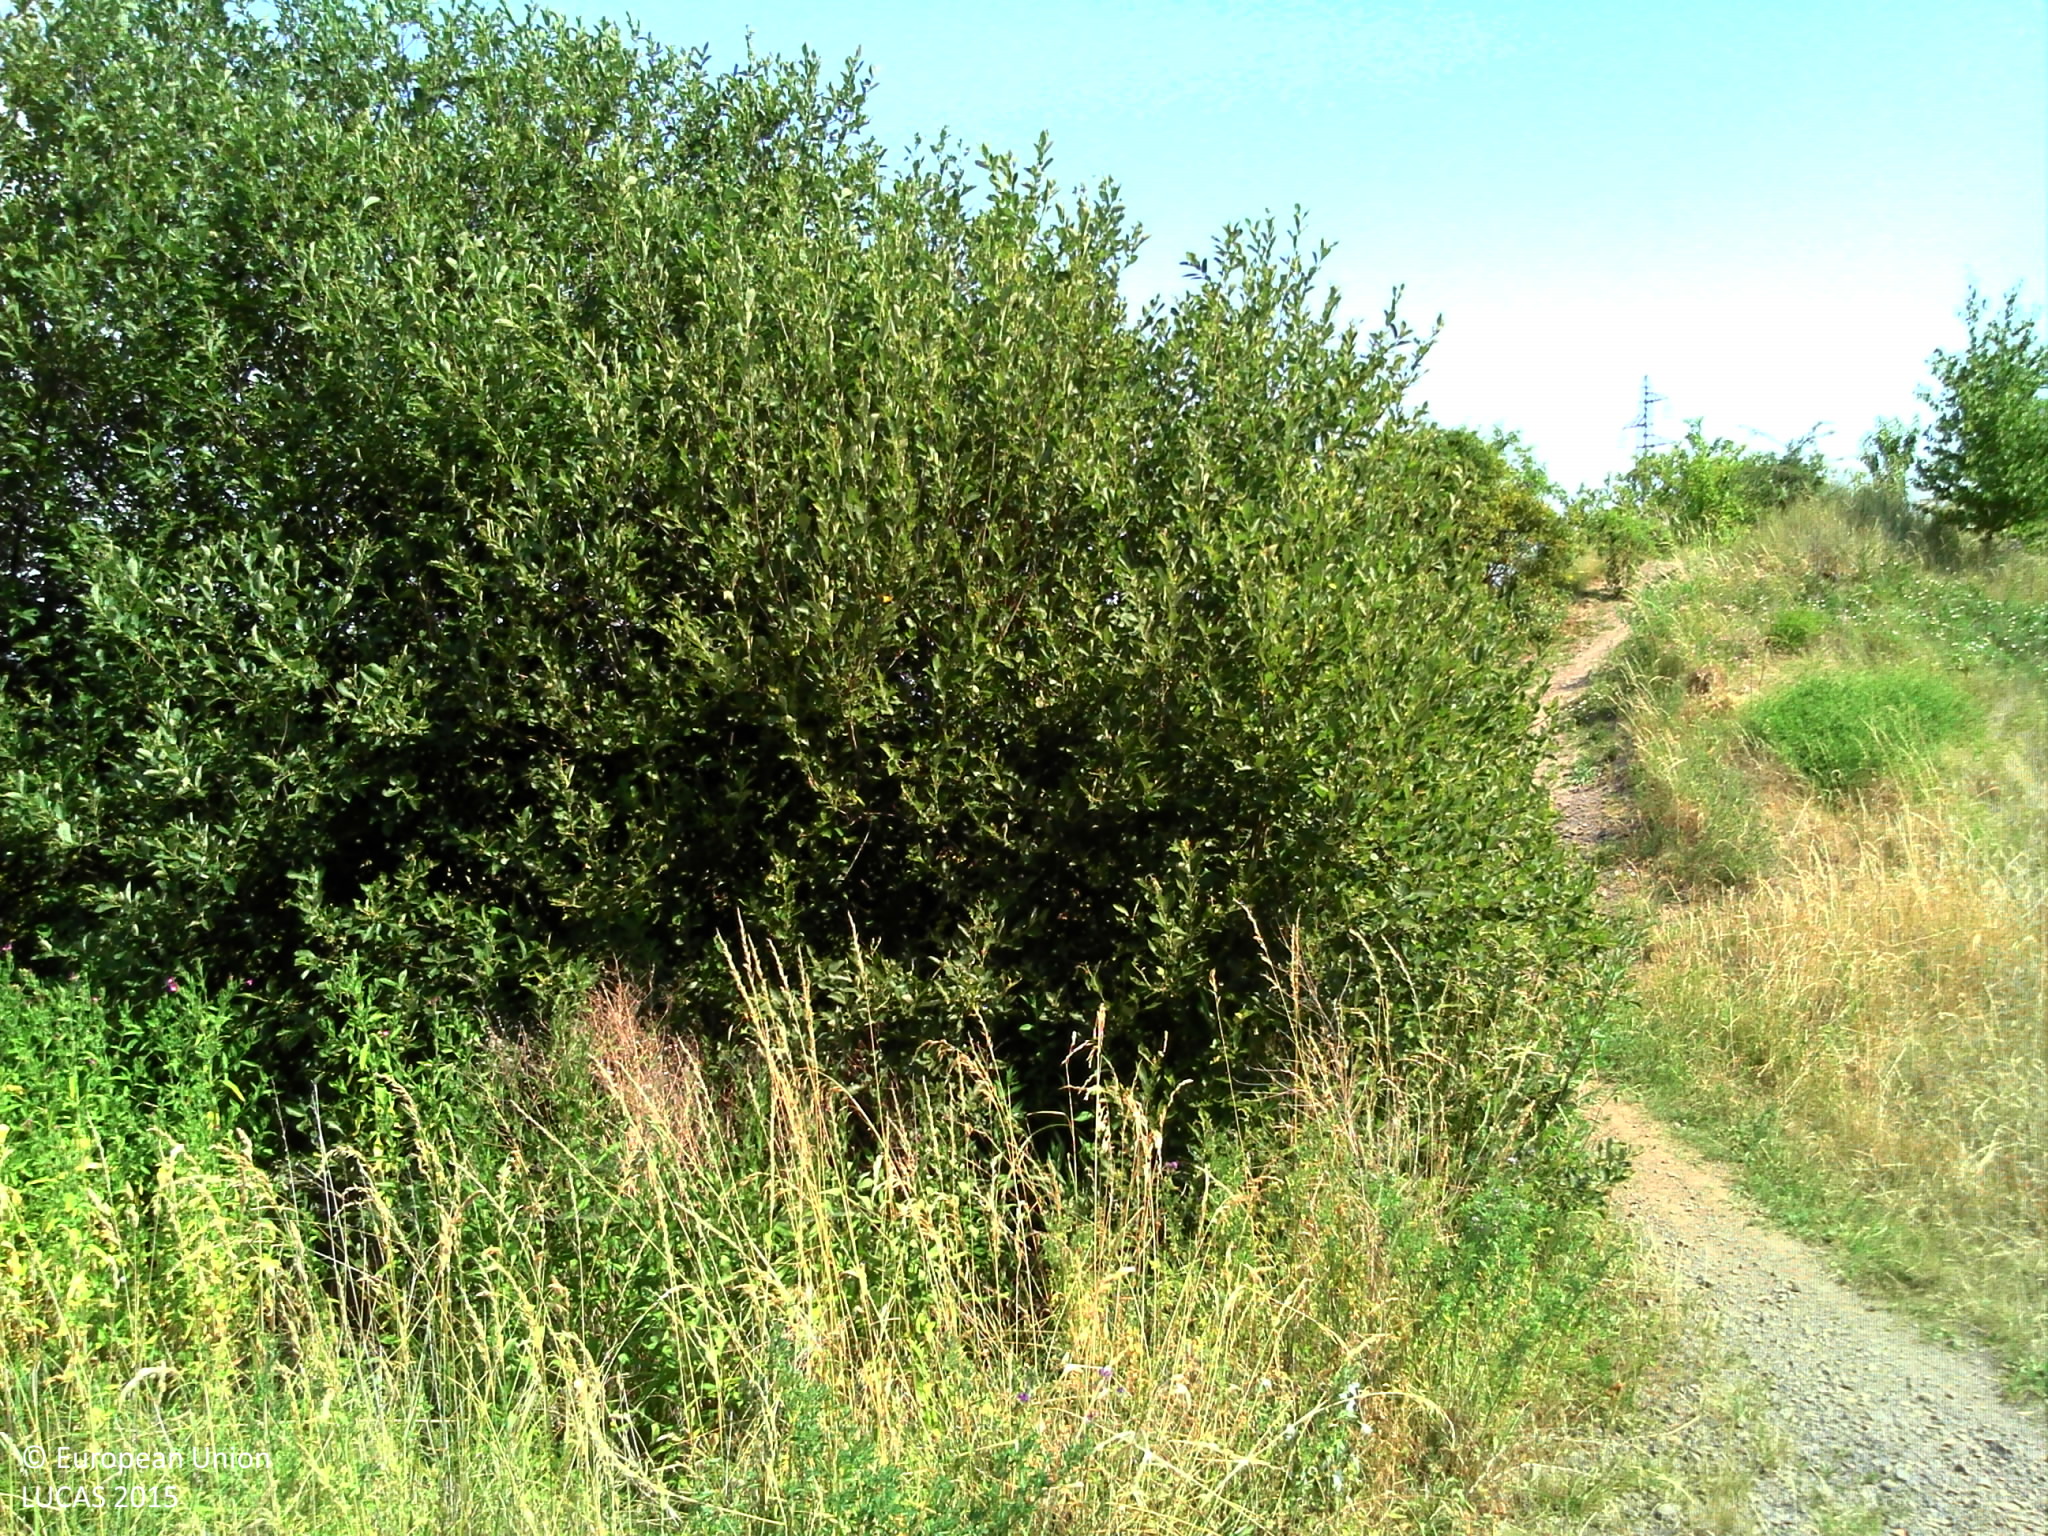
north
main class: Shrubland
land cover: Shrubland without tree cover
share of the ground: > 75 %
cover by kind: herbaceous plants 70 %, shrubs 30 %
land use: Sport
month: July
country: FR
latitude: 45.8006
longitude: 3.0646
